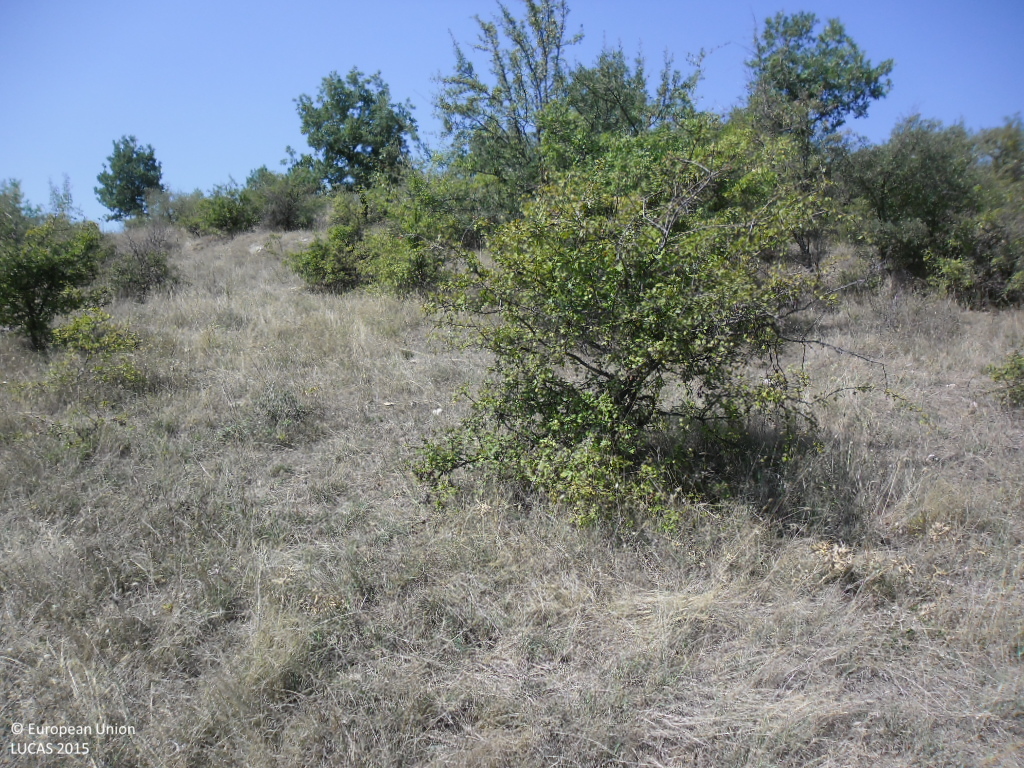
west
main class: Grassland
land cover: Grassland with sparse tree/shrub cover
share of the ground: > 75 %
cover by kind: herbaceous plants 90 %, broadleaved forest trees 5 %, shrubs 5 %
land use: Agriculture (excluding fallow land and kitchen gardens)
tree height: < 5 m
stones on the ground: < 10 %
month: August
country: BG
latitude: 42.0127
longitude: 23.0038
